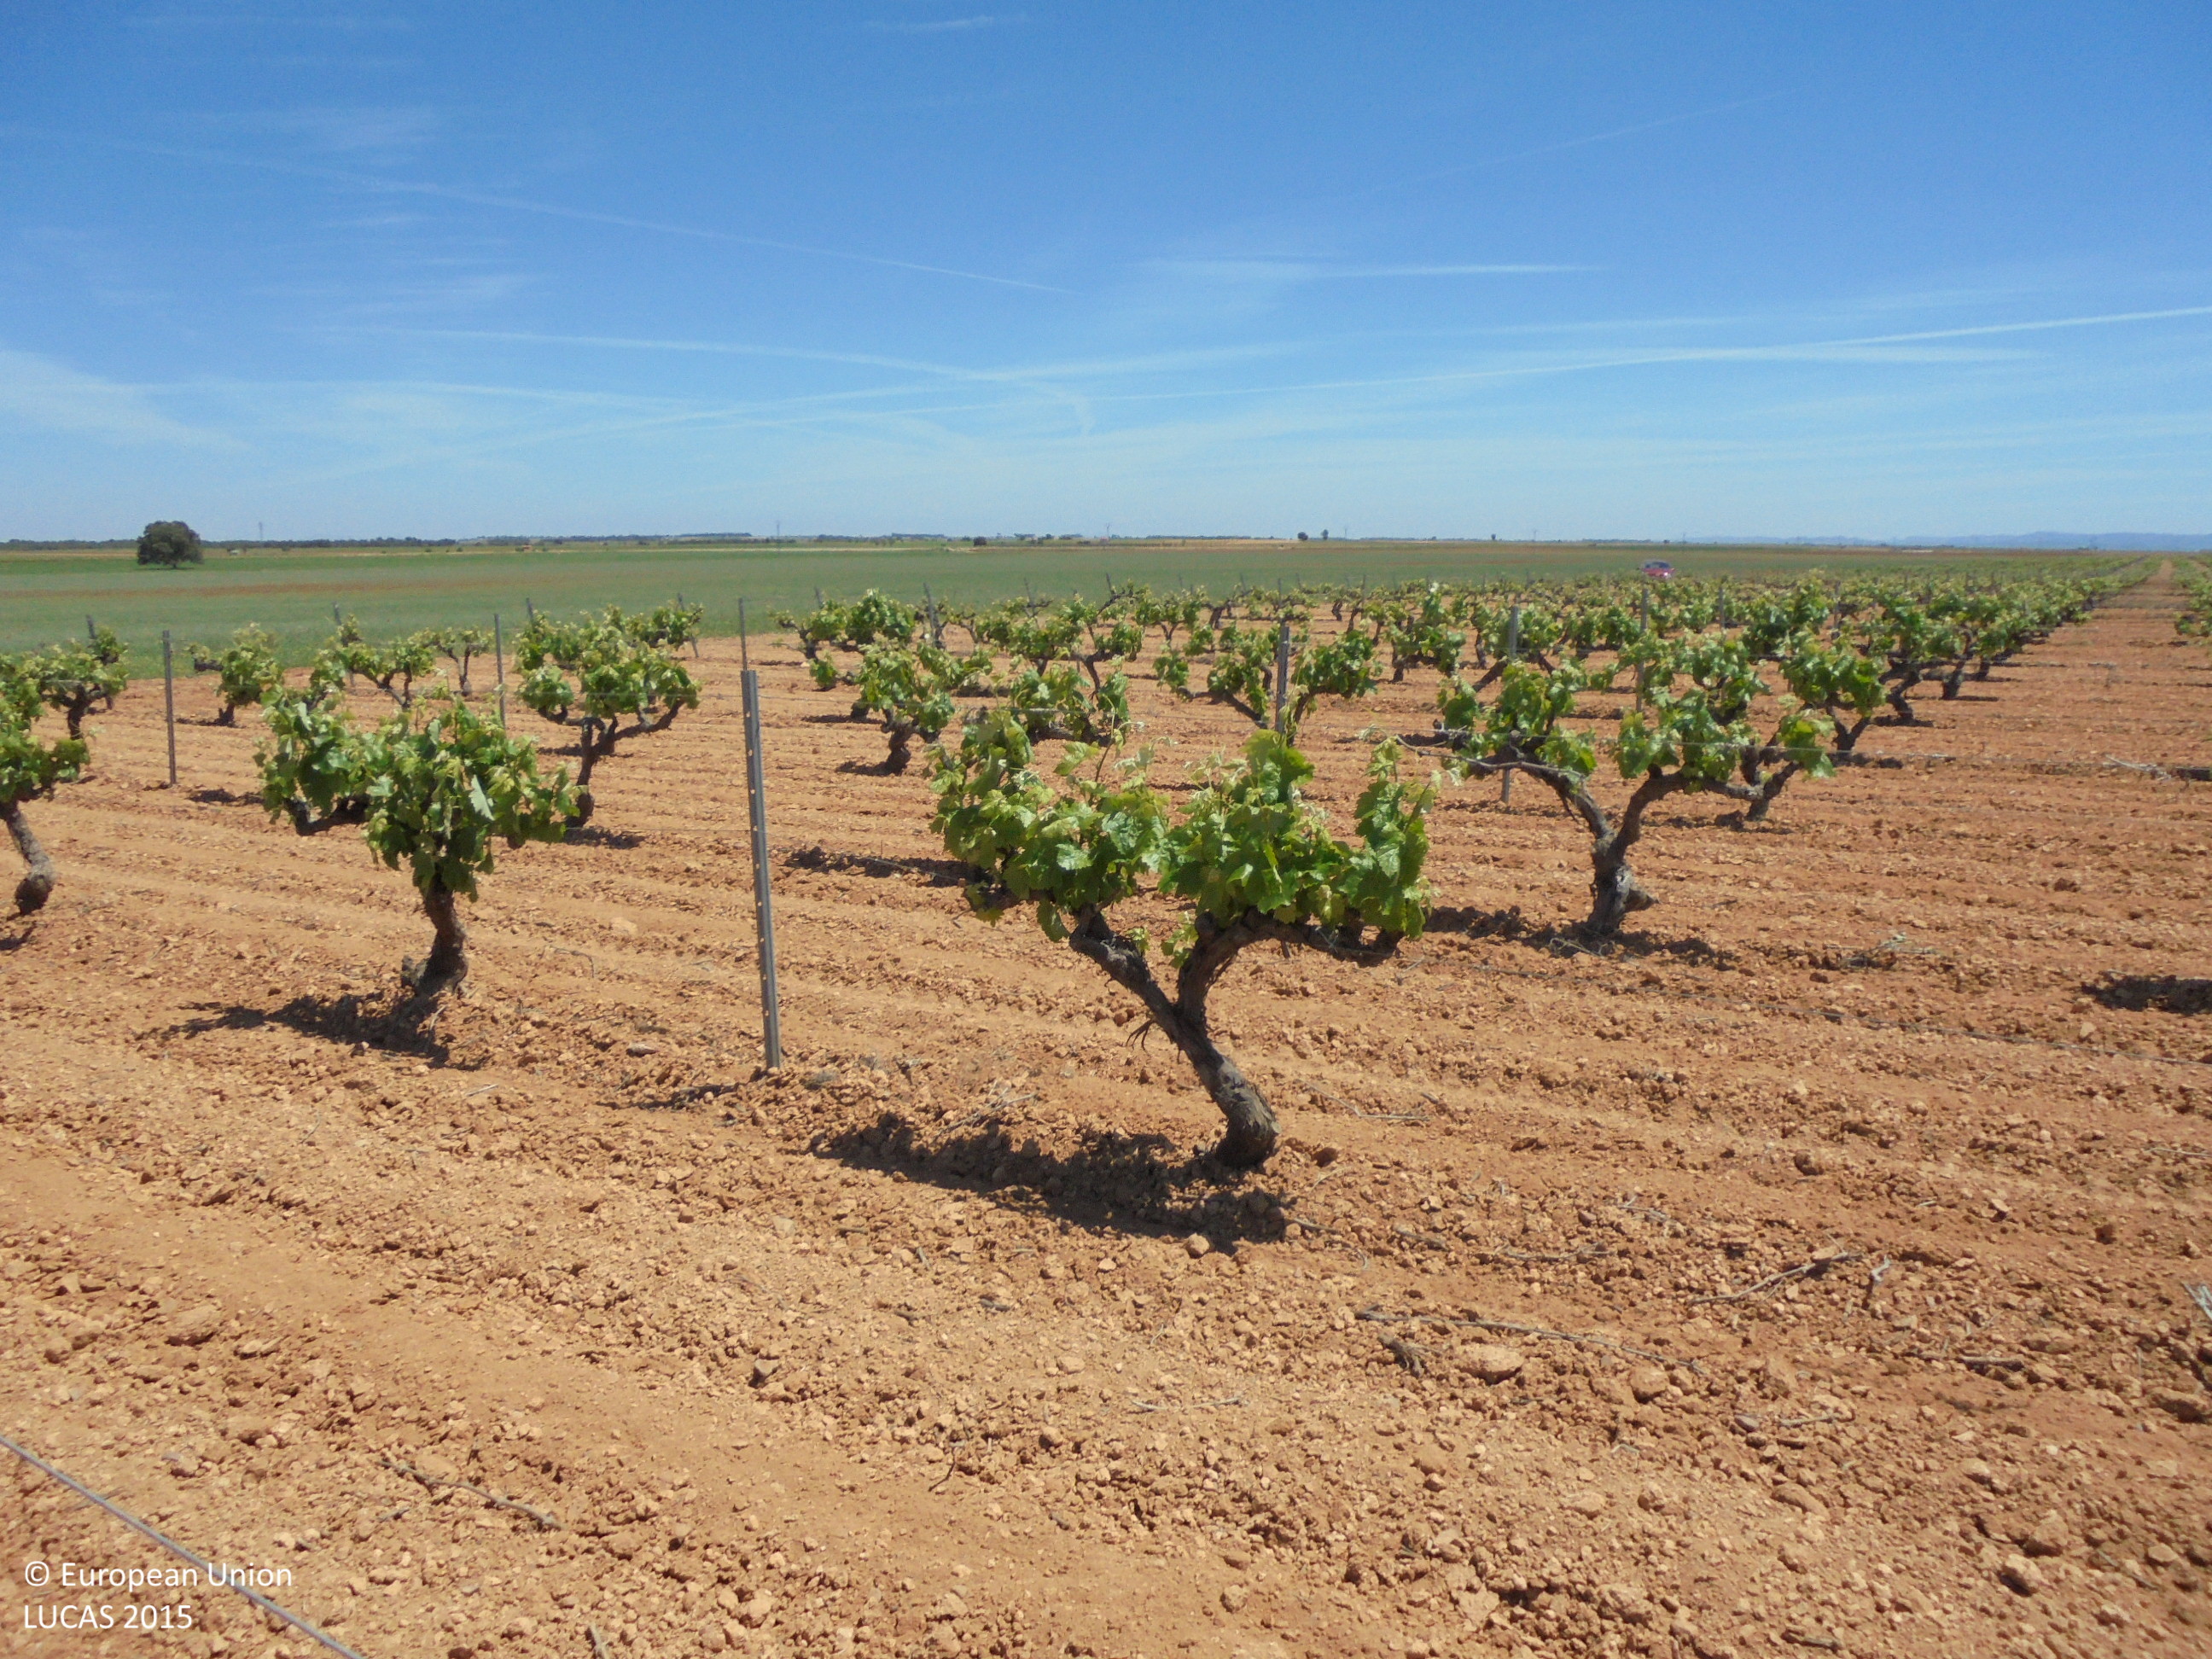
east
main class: Cropland
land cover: Vineyards
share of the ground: 10 - 25 %
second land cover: Other bare soil
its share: > 75 %
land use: Agriculture (excluding fallow land and kitchen gardens)
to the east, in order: Vineyards; Other bare soil; Grass margins; Tracks; Grass margins; Durum wheat
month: May
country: ES
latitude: 39.3126
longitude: -1.5186
